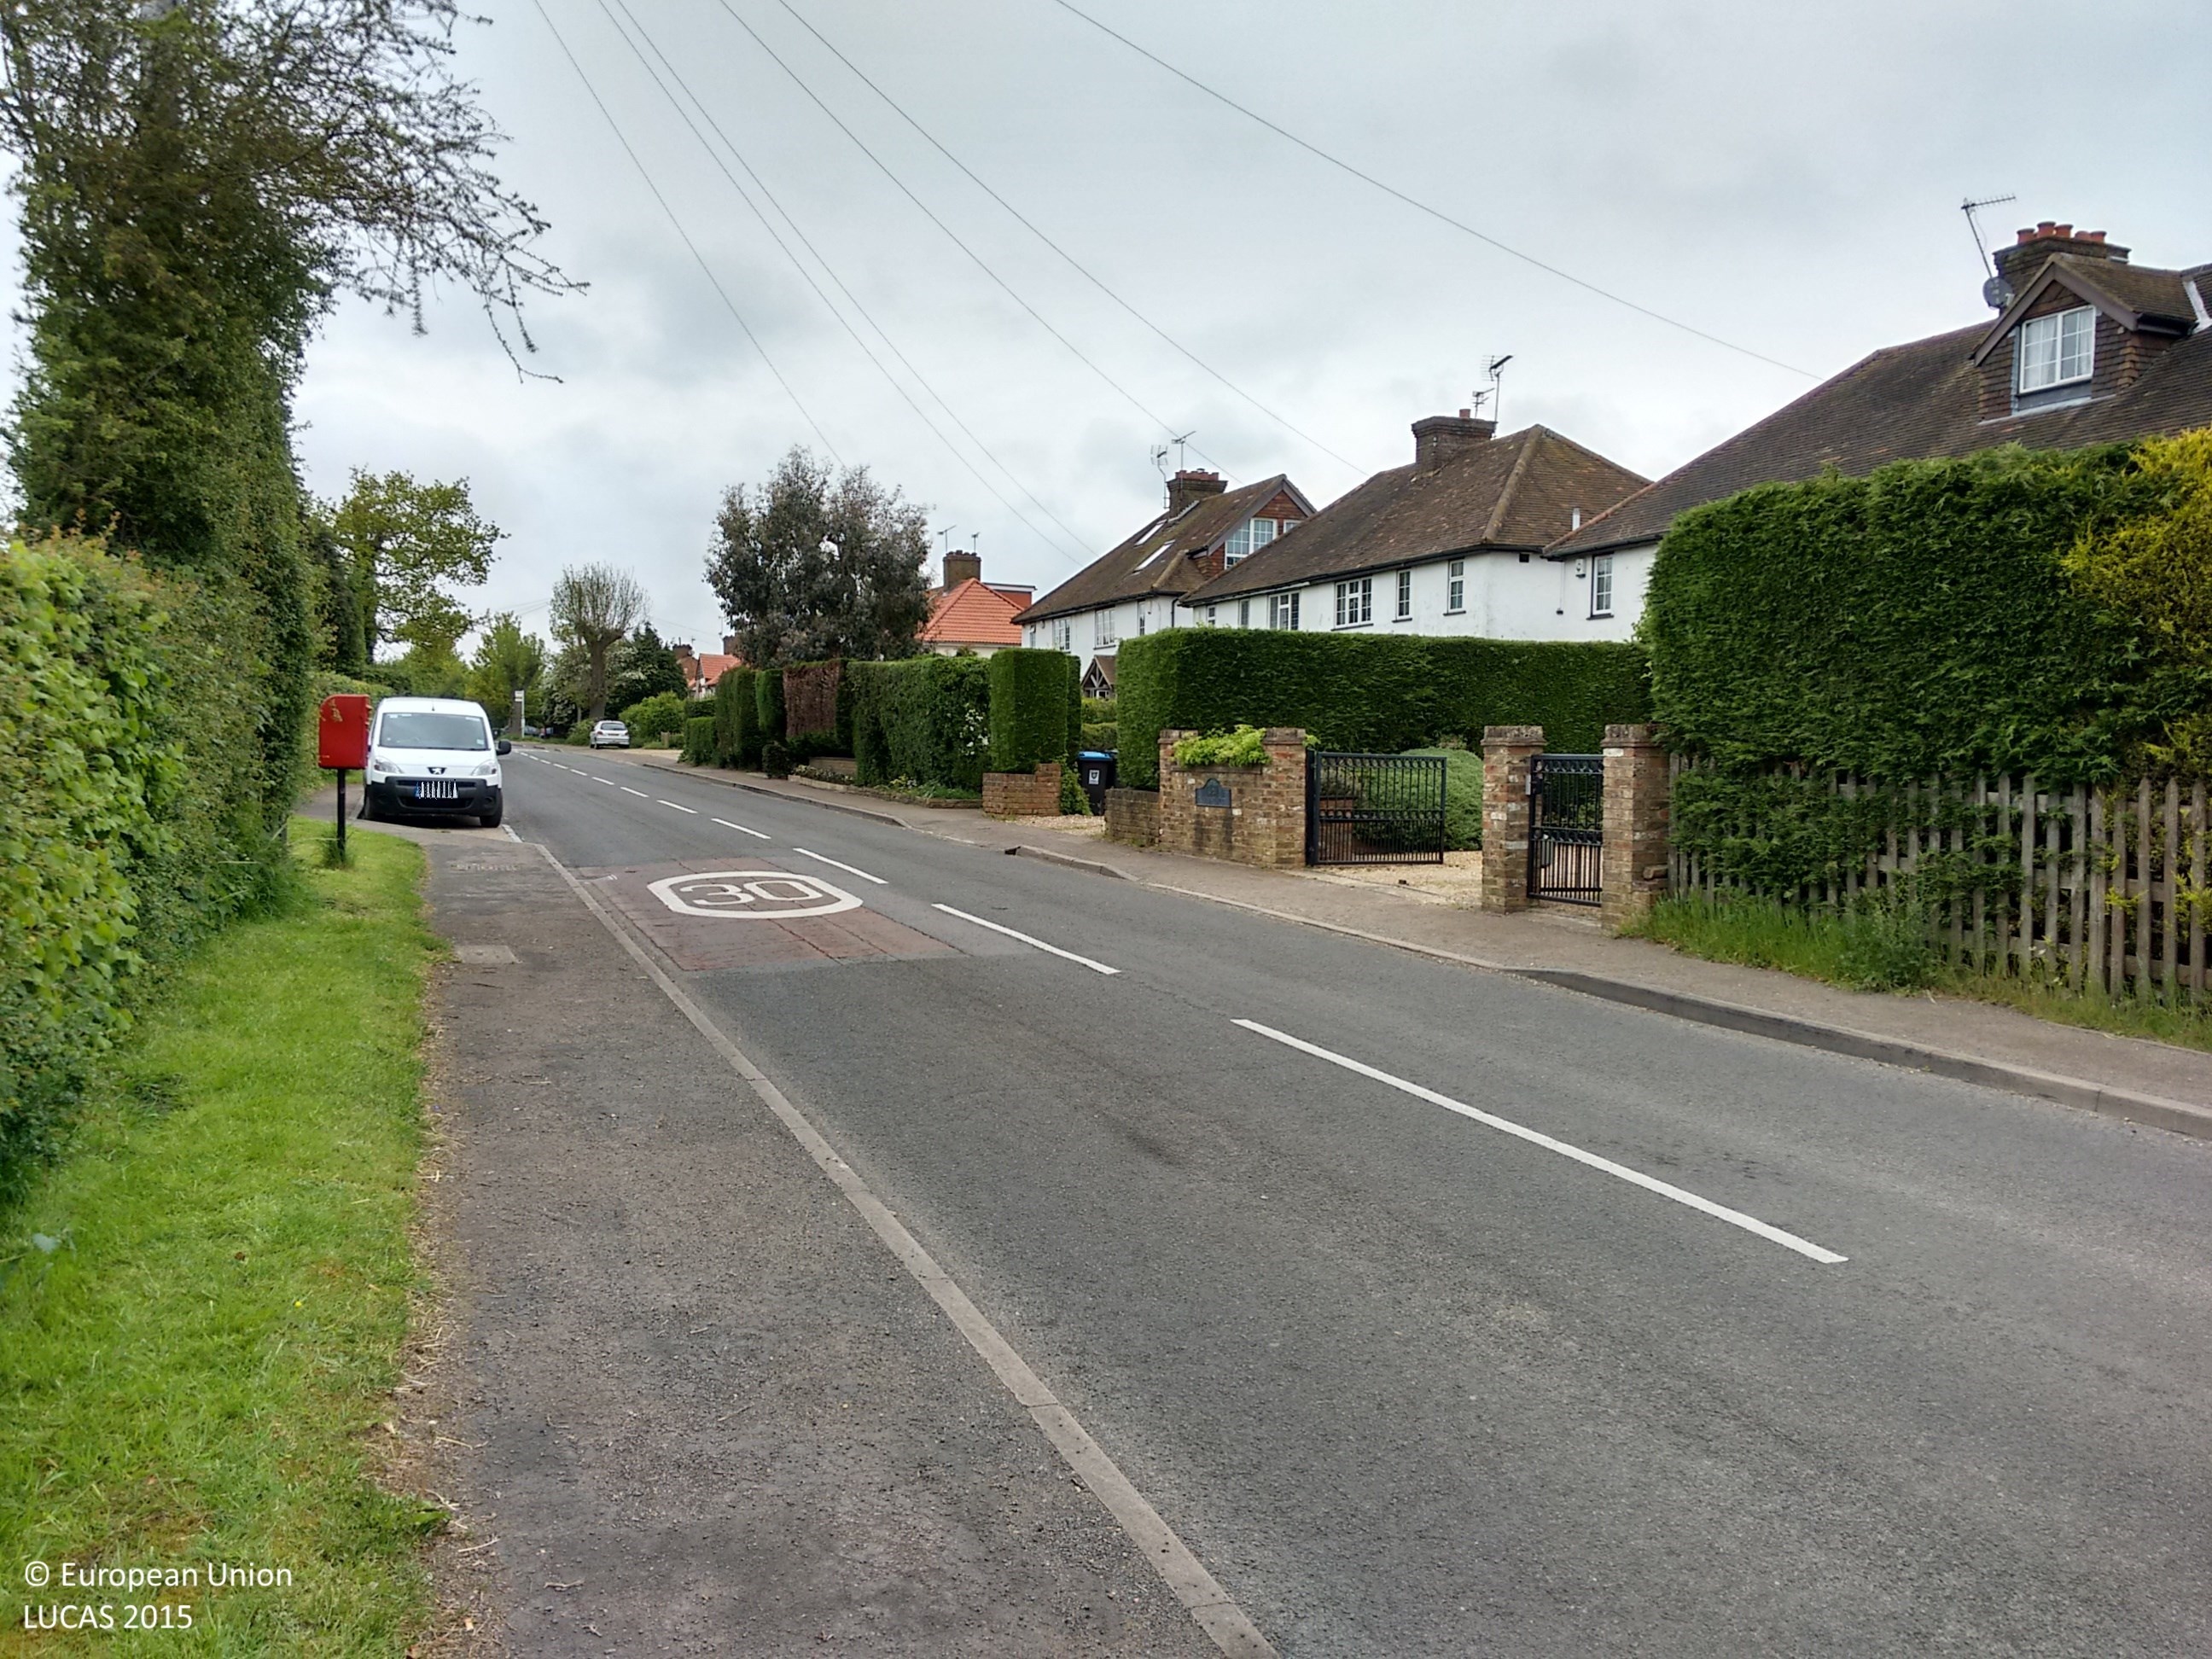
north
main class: Grassland
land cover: Grassland without tree/shrub cover
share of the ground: > 75 %
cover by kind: herbaceous plants 100 %
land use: Agriculture (excluding fallow land and kitchen gardens)
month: May
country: GB
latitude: 51.7108
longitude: -0.5020
